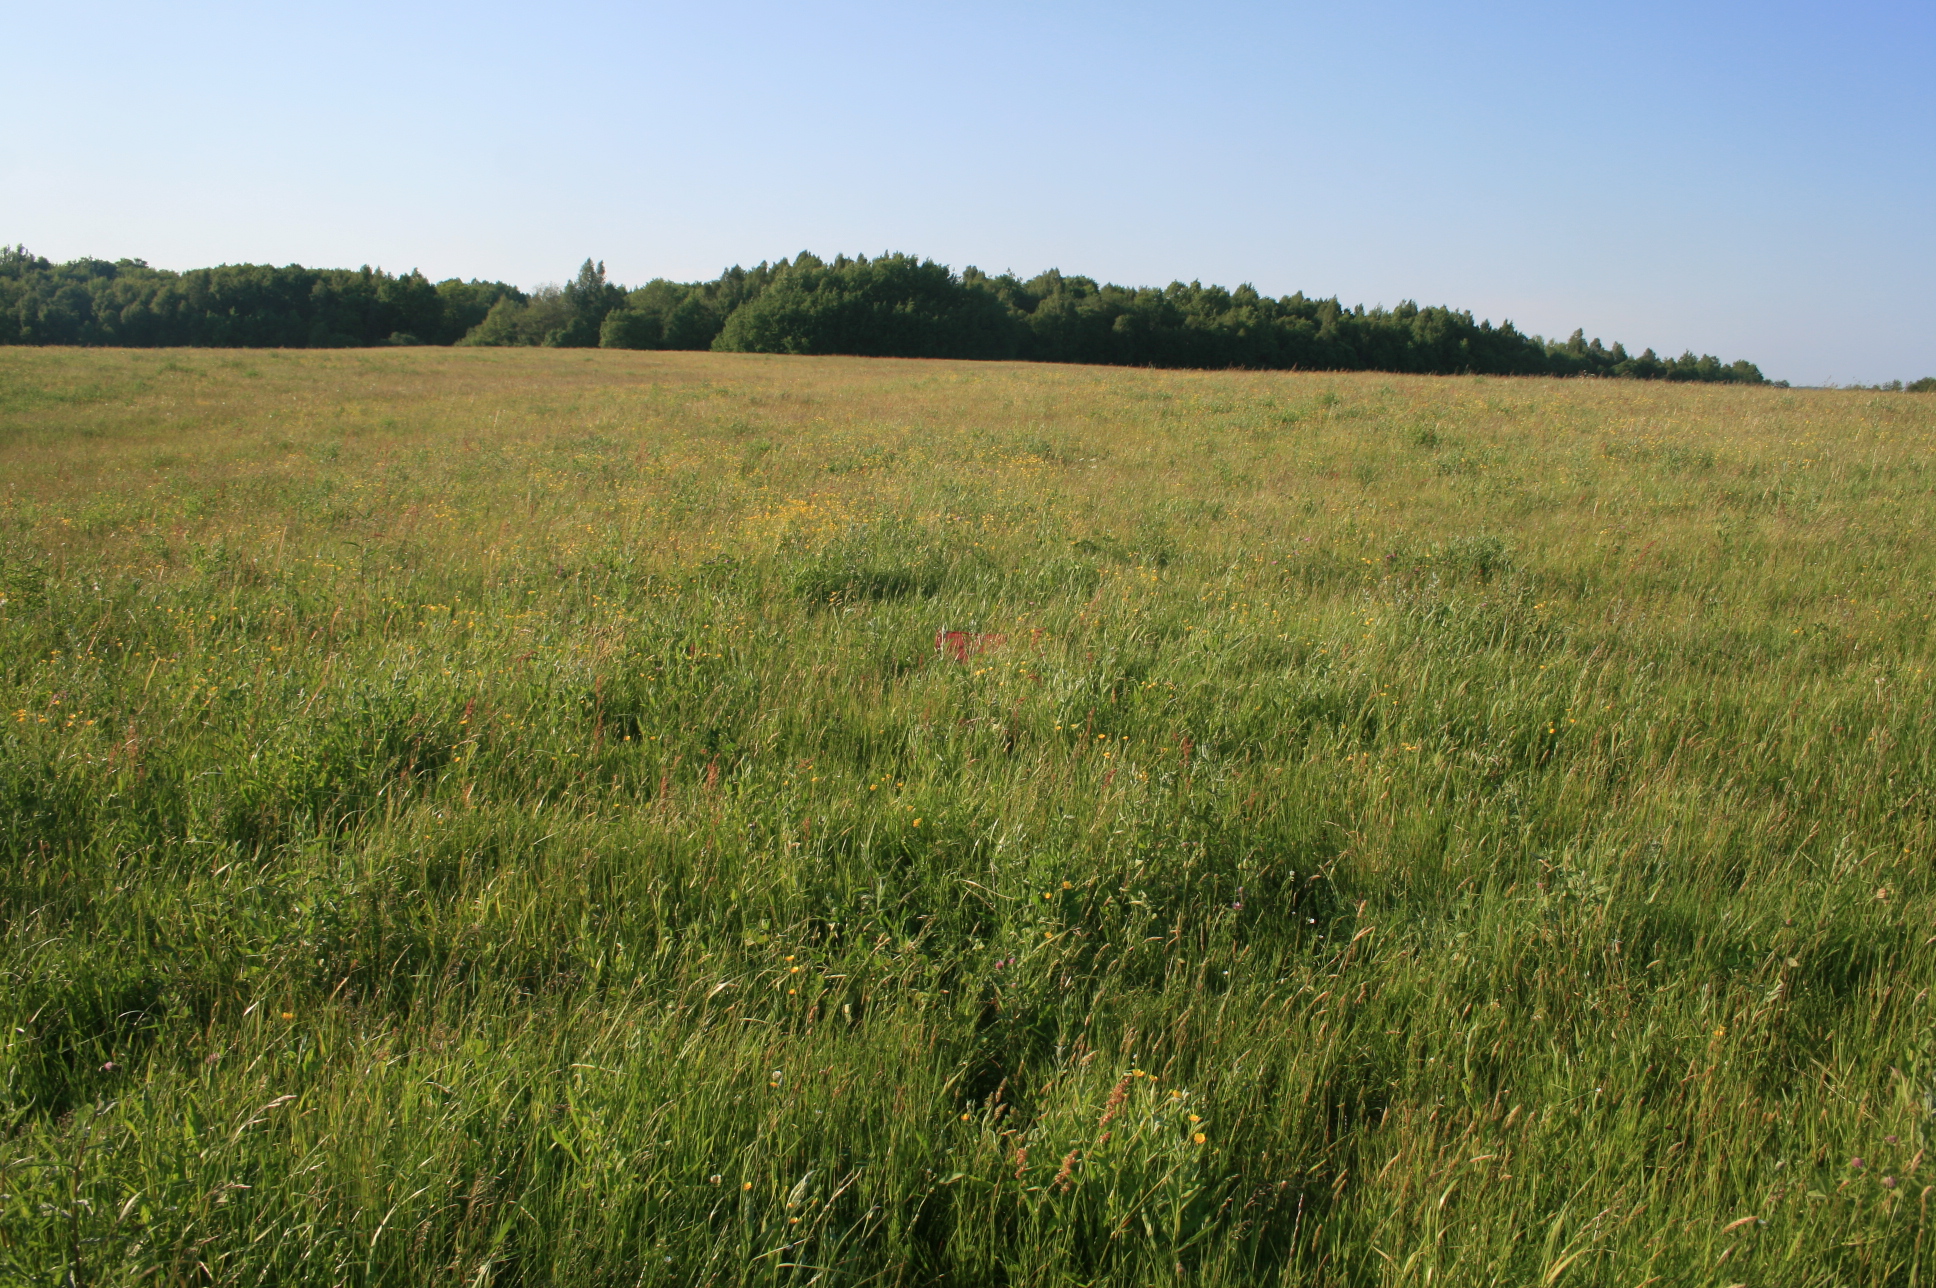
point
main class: Grassland
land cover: Grassland without tree/shrub cover
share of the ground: > 75 %
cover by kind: herbaceous plants 100 %
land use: Agriculture (excluding fallow land and kitchen gardens)
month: June
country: LT
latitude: 55.6739
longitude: 22.2201
